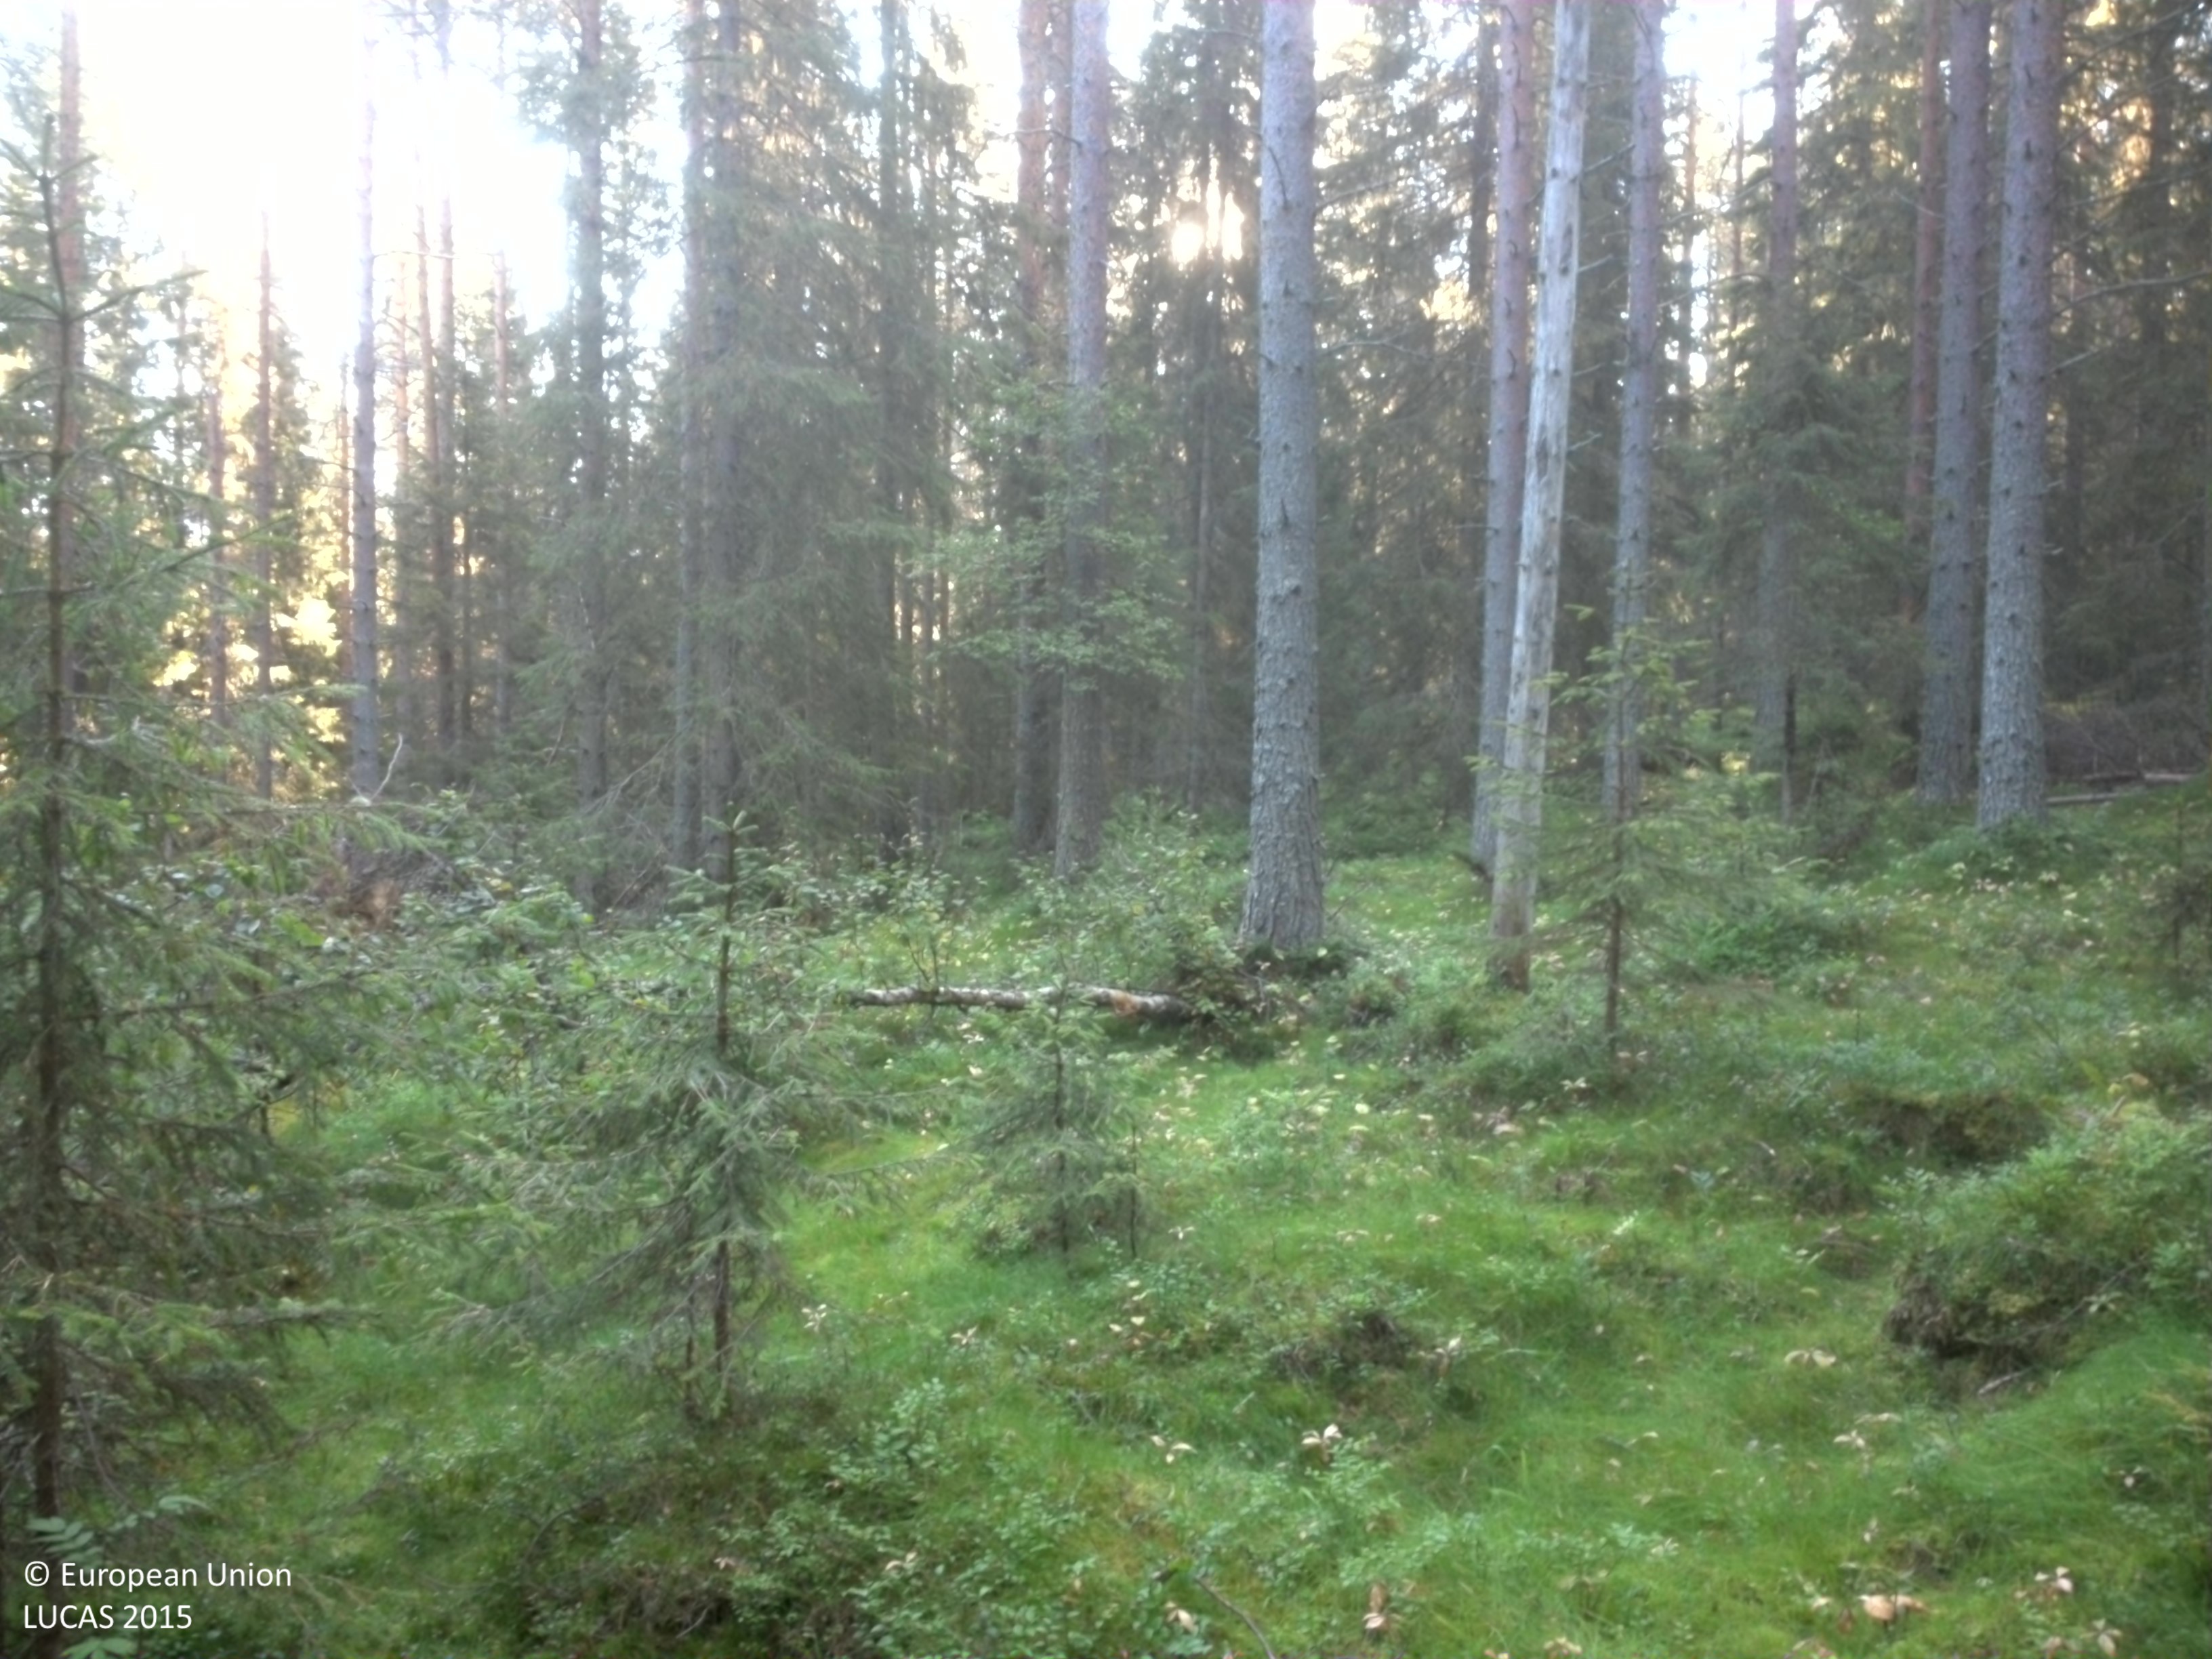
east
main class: Woodland
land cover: Other coniferous woodland
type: boreal forest
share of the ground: 25 - 50 %
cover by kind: coniferous forest trees 40 %, shrubs 30 %, lichens and mosses 20 %, herbaceous plants 10 %
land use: Forestry
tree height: > 5 m
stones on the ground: > 50 %
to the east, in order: Other coniferous woodland; Spruce dominated coniferous woodland
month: September
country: SE
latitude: 64.6395
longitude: 19.8277
